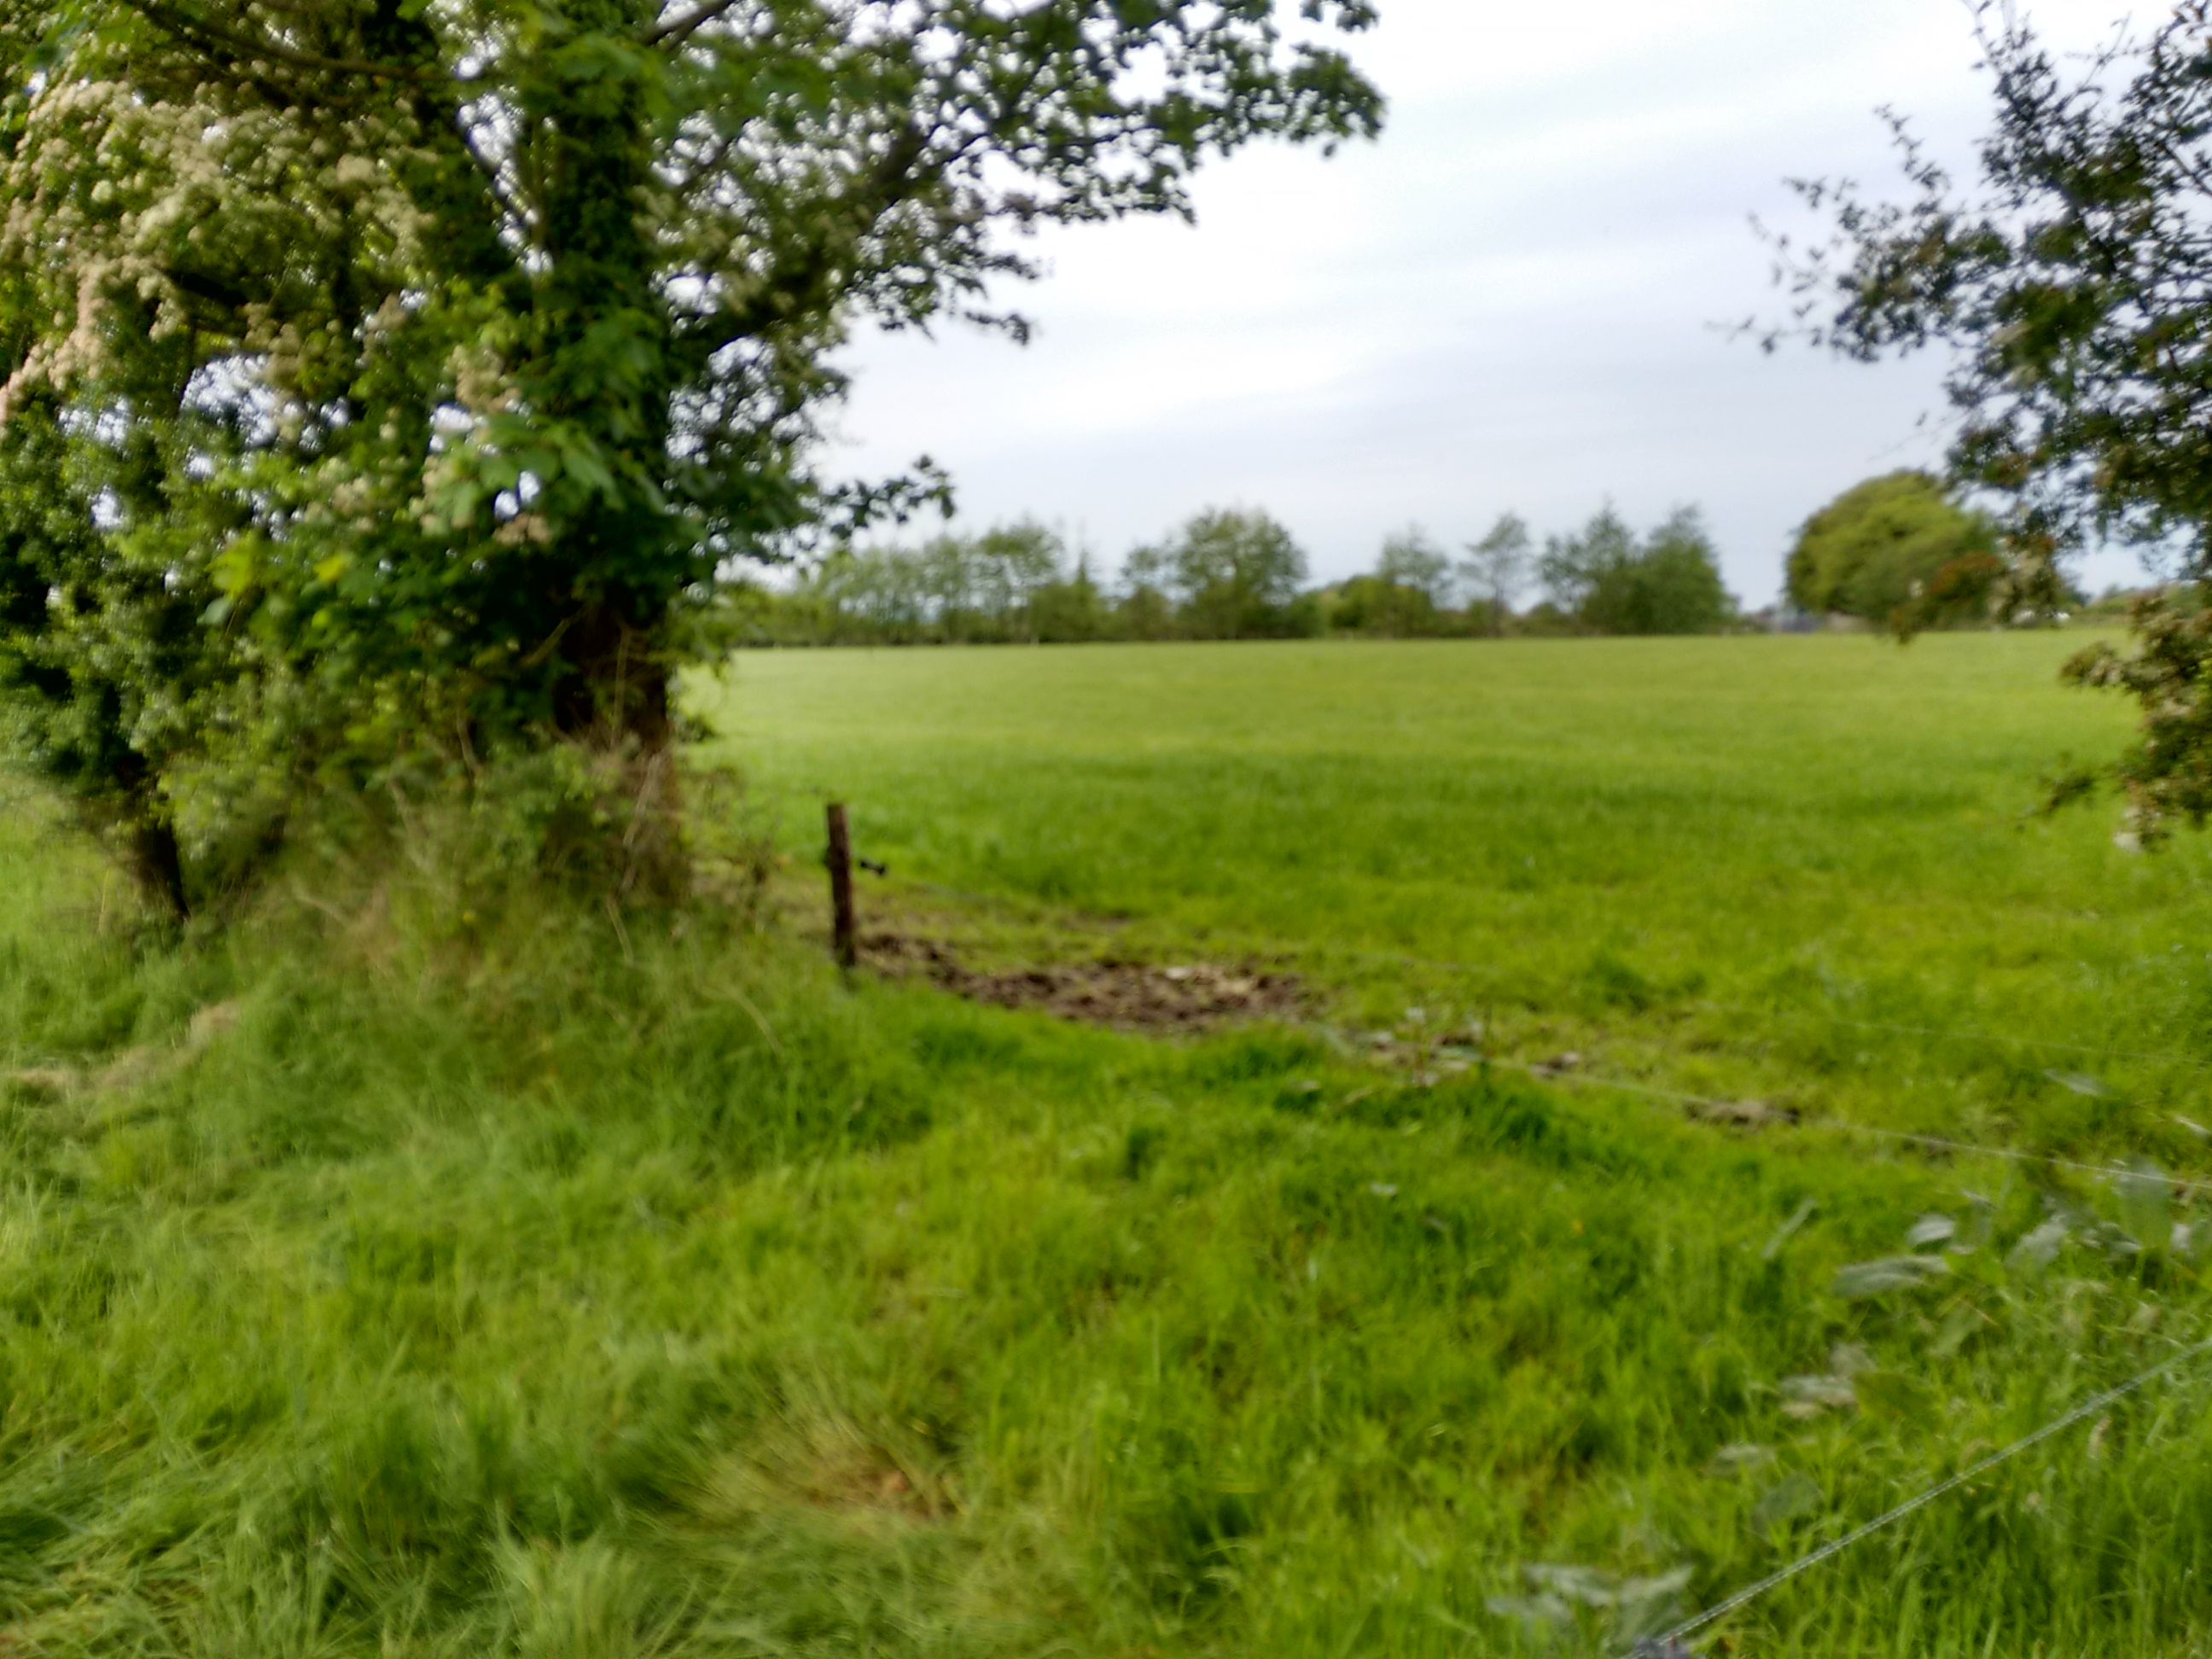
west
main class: Grassland
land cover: Grassland without tree/shrub cover
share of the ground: > 75 %
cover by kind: herbaceous plants 100 %
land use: Agriculture (excluding fallow land and kitchen gardens)
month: June
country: IE
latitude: 53.4333
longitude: -8.6369
